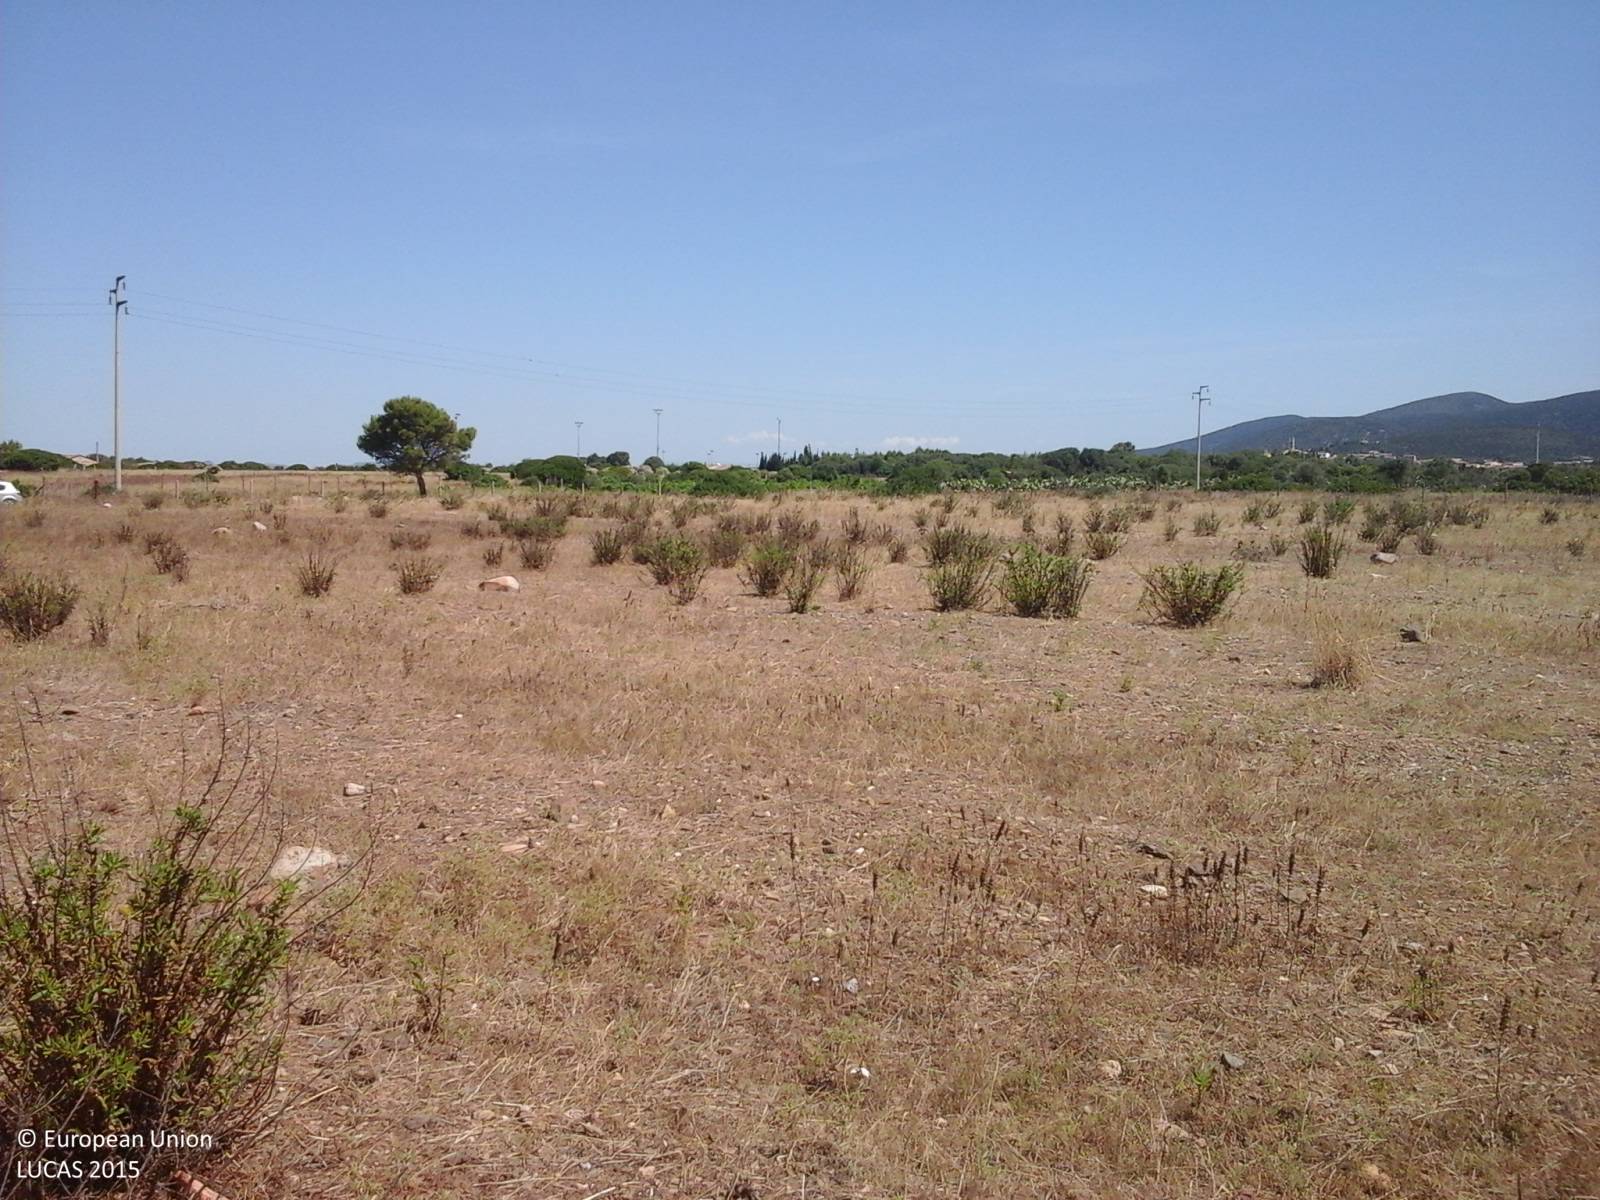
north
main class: Grassland
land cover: Grassland without tree/shrub cover
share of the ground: > 75 %
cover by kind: herbaceous plants 95 %, shrubs 5 %
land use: Agriculture (excluding fallow land and kitchen gardens)
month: June
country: IT
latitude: 38.9896
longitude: 8.6349
